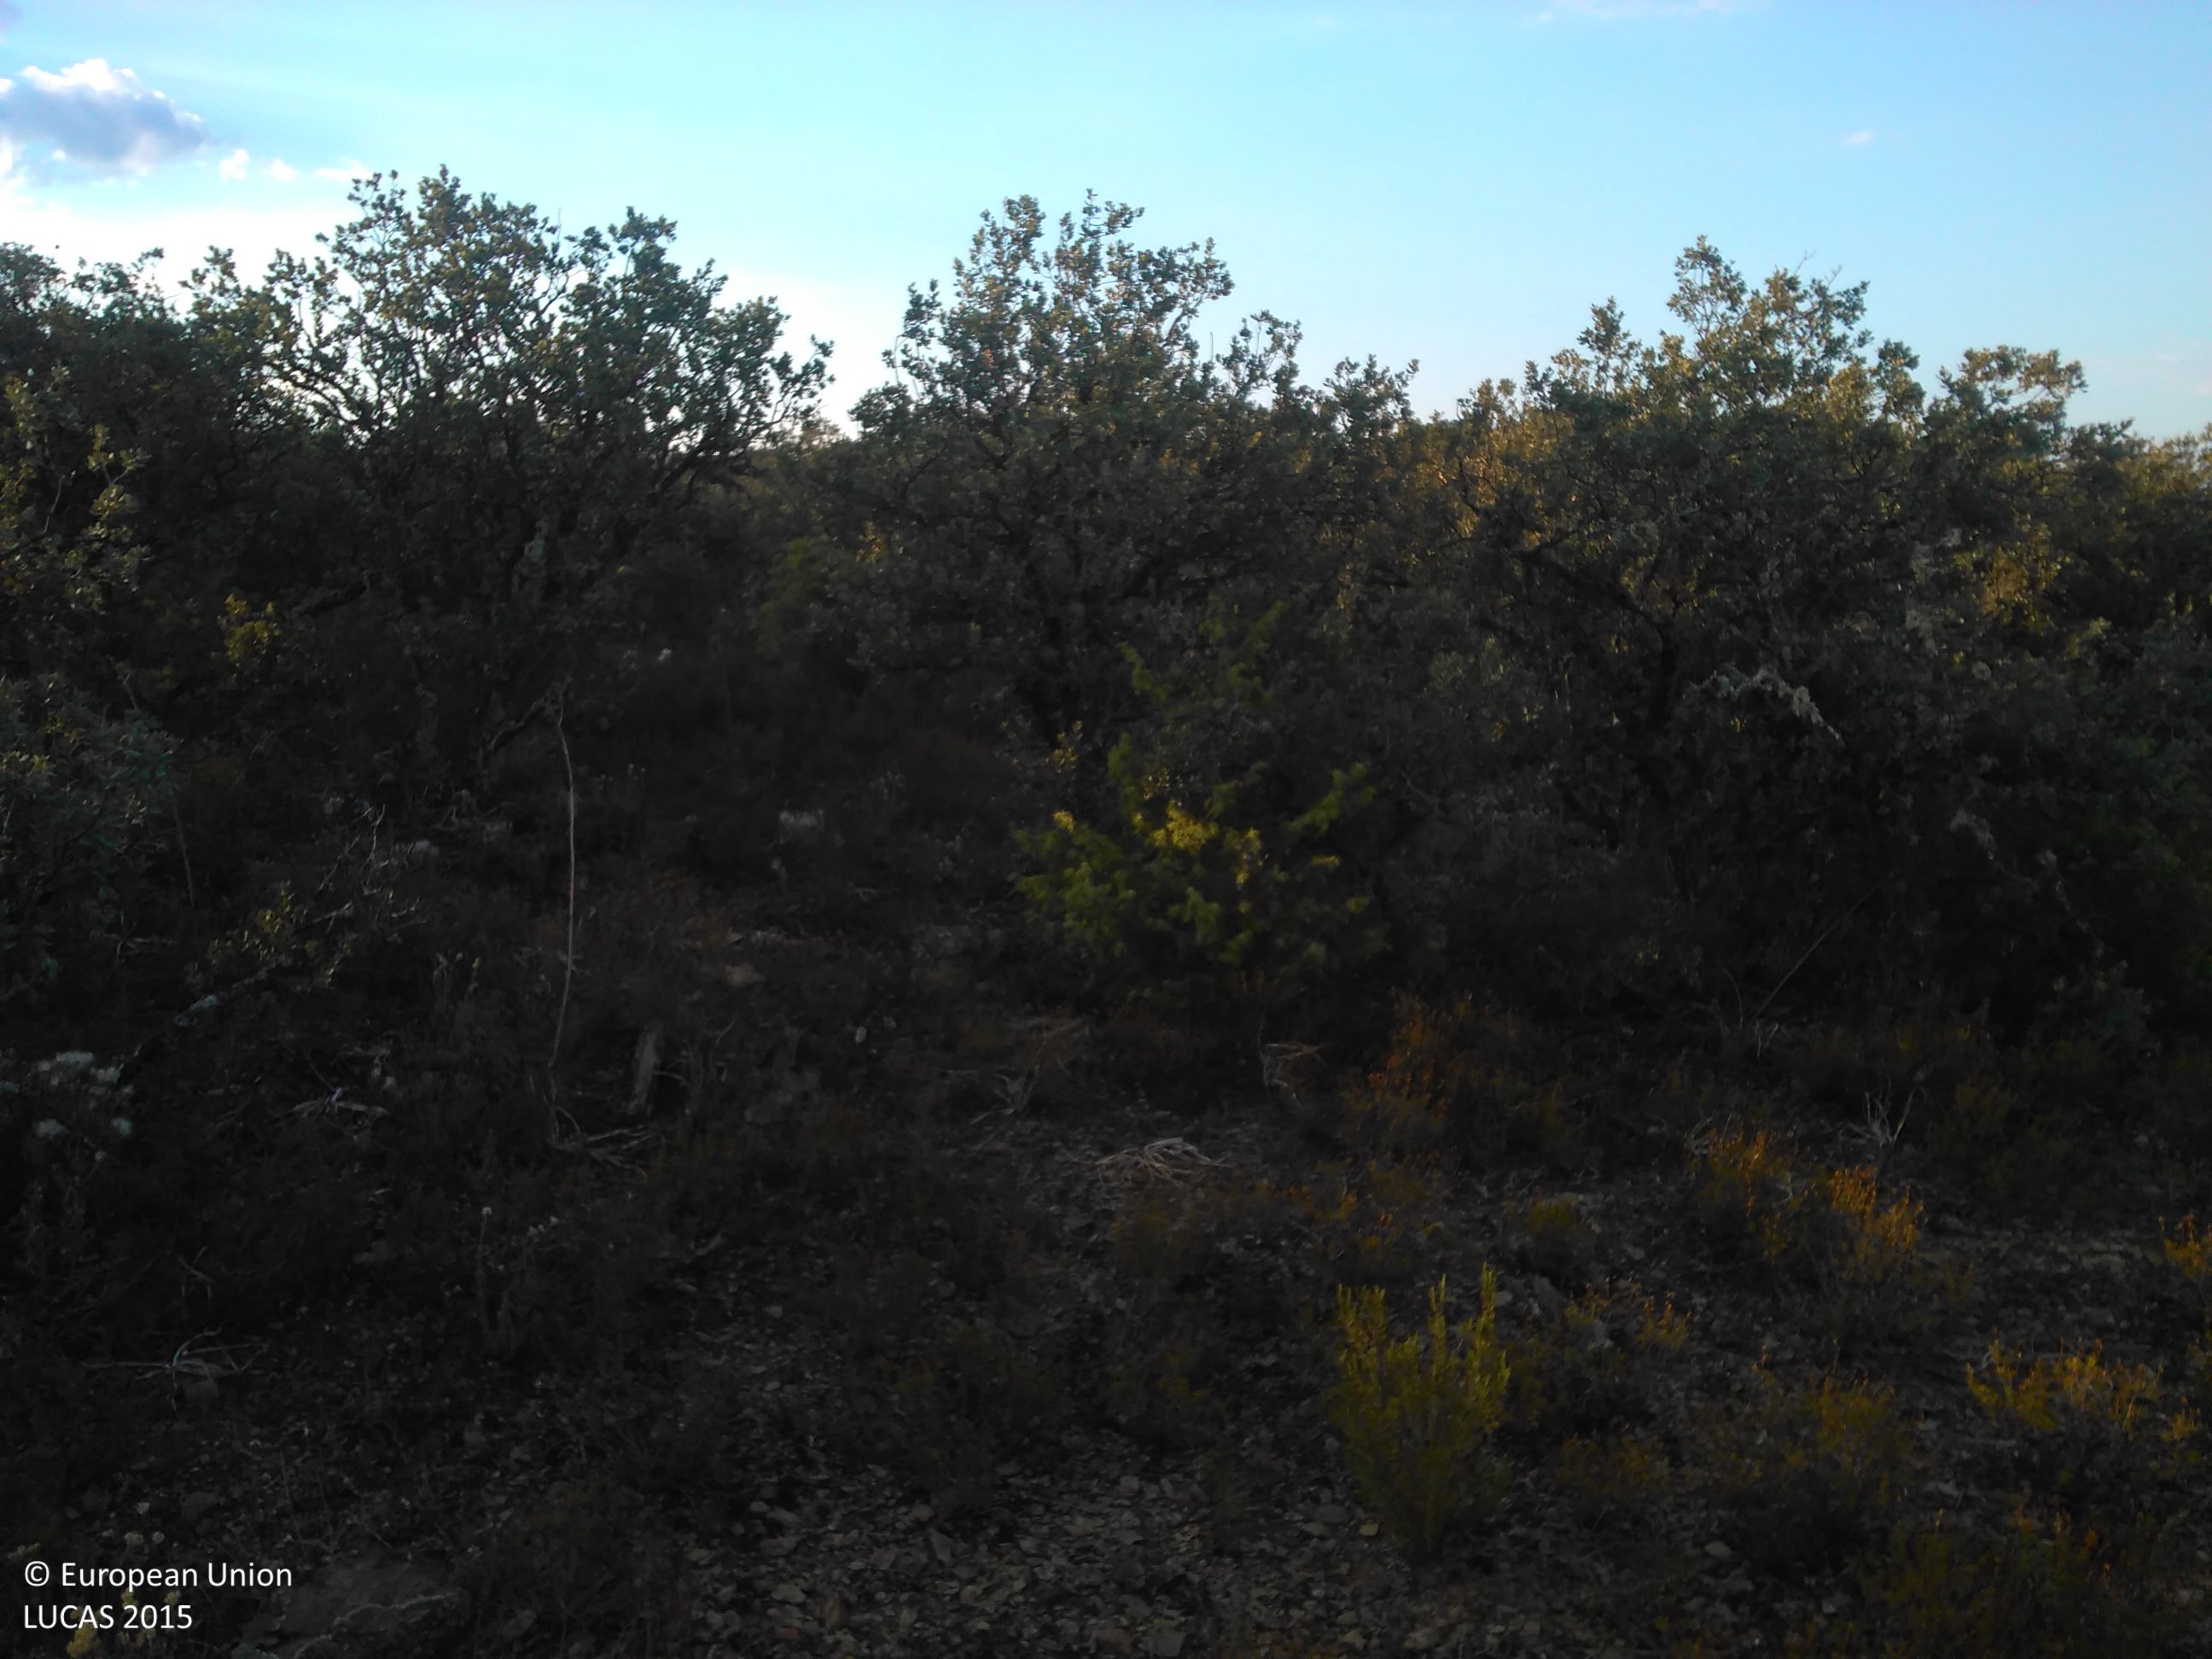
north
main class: Woodland
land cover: Broadleaved woodland
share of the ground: 50 - 75 %
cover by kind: broadleaved forest trees 50 %, shrubs 30 %, unconsolidated bare surface 20 %
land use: Semi-natural and natural areas not in use
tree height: < 5 m
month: July
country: ES
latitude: 41.4226
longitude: -1.8858
